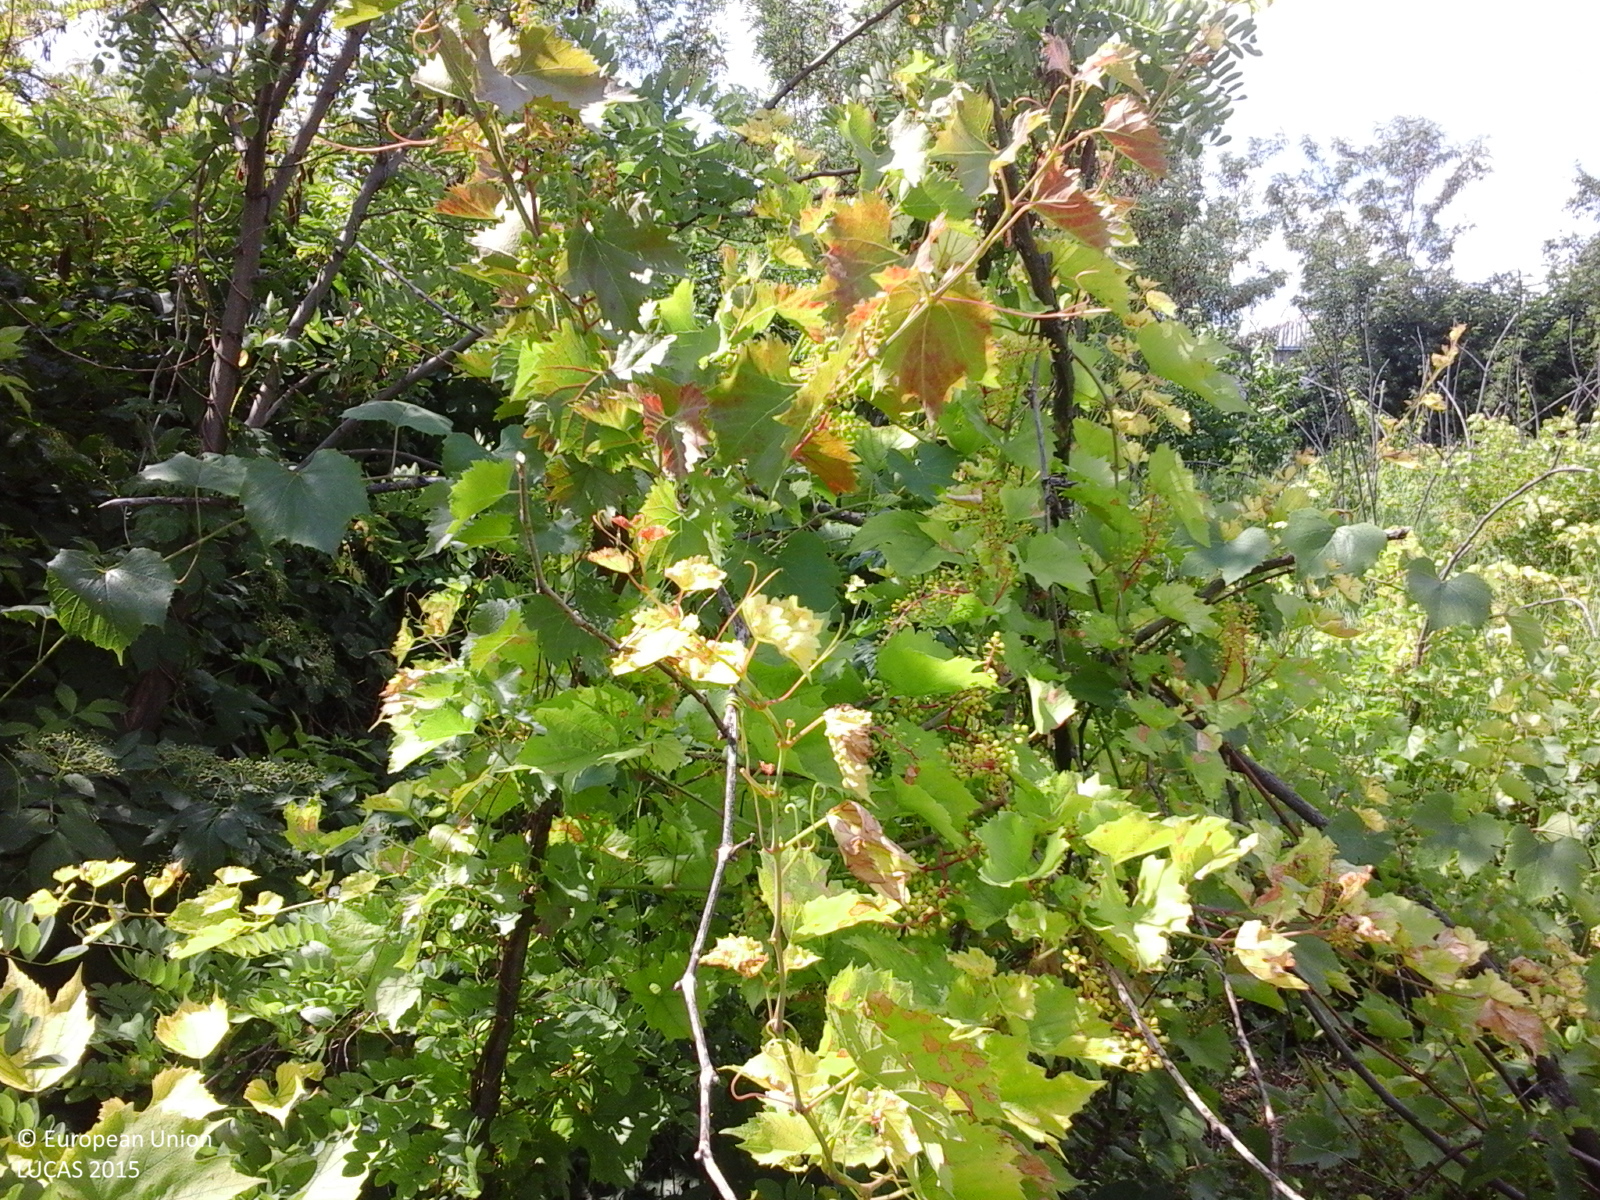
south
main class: Cropland
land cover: Vineyards
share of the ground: 50 - 75 %
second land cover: Grassland without tree/shrub cover
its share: 10 - 25 %
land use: Agriculture (excluding fallow land and kitchen gardens)
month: June
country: RO
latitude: 47.4781
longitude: 26.8858
